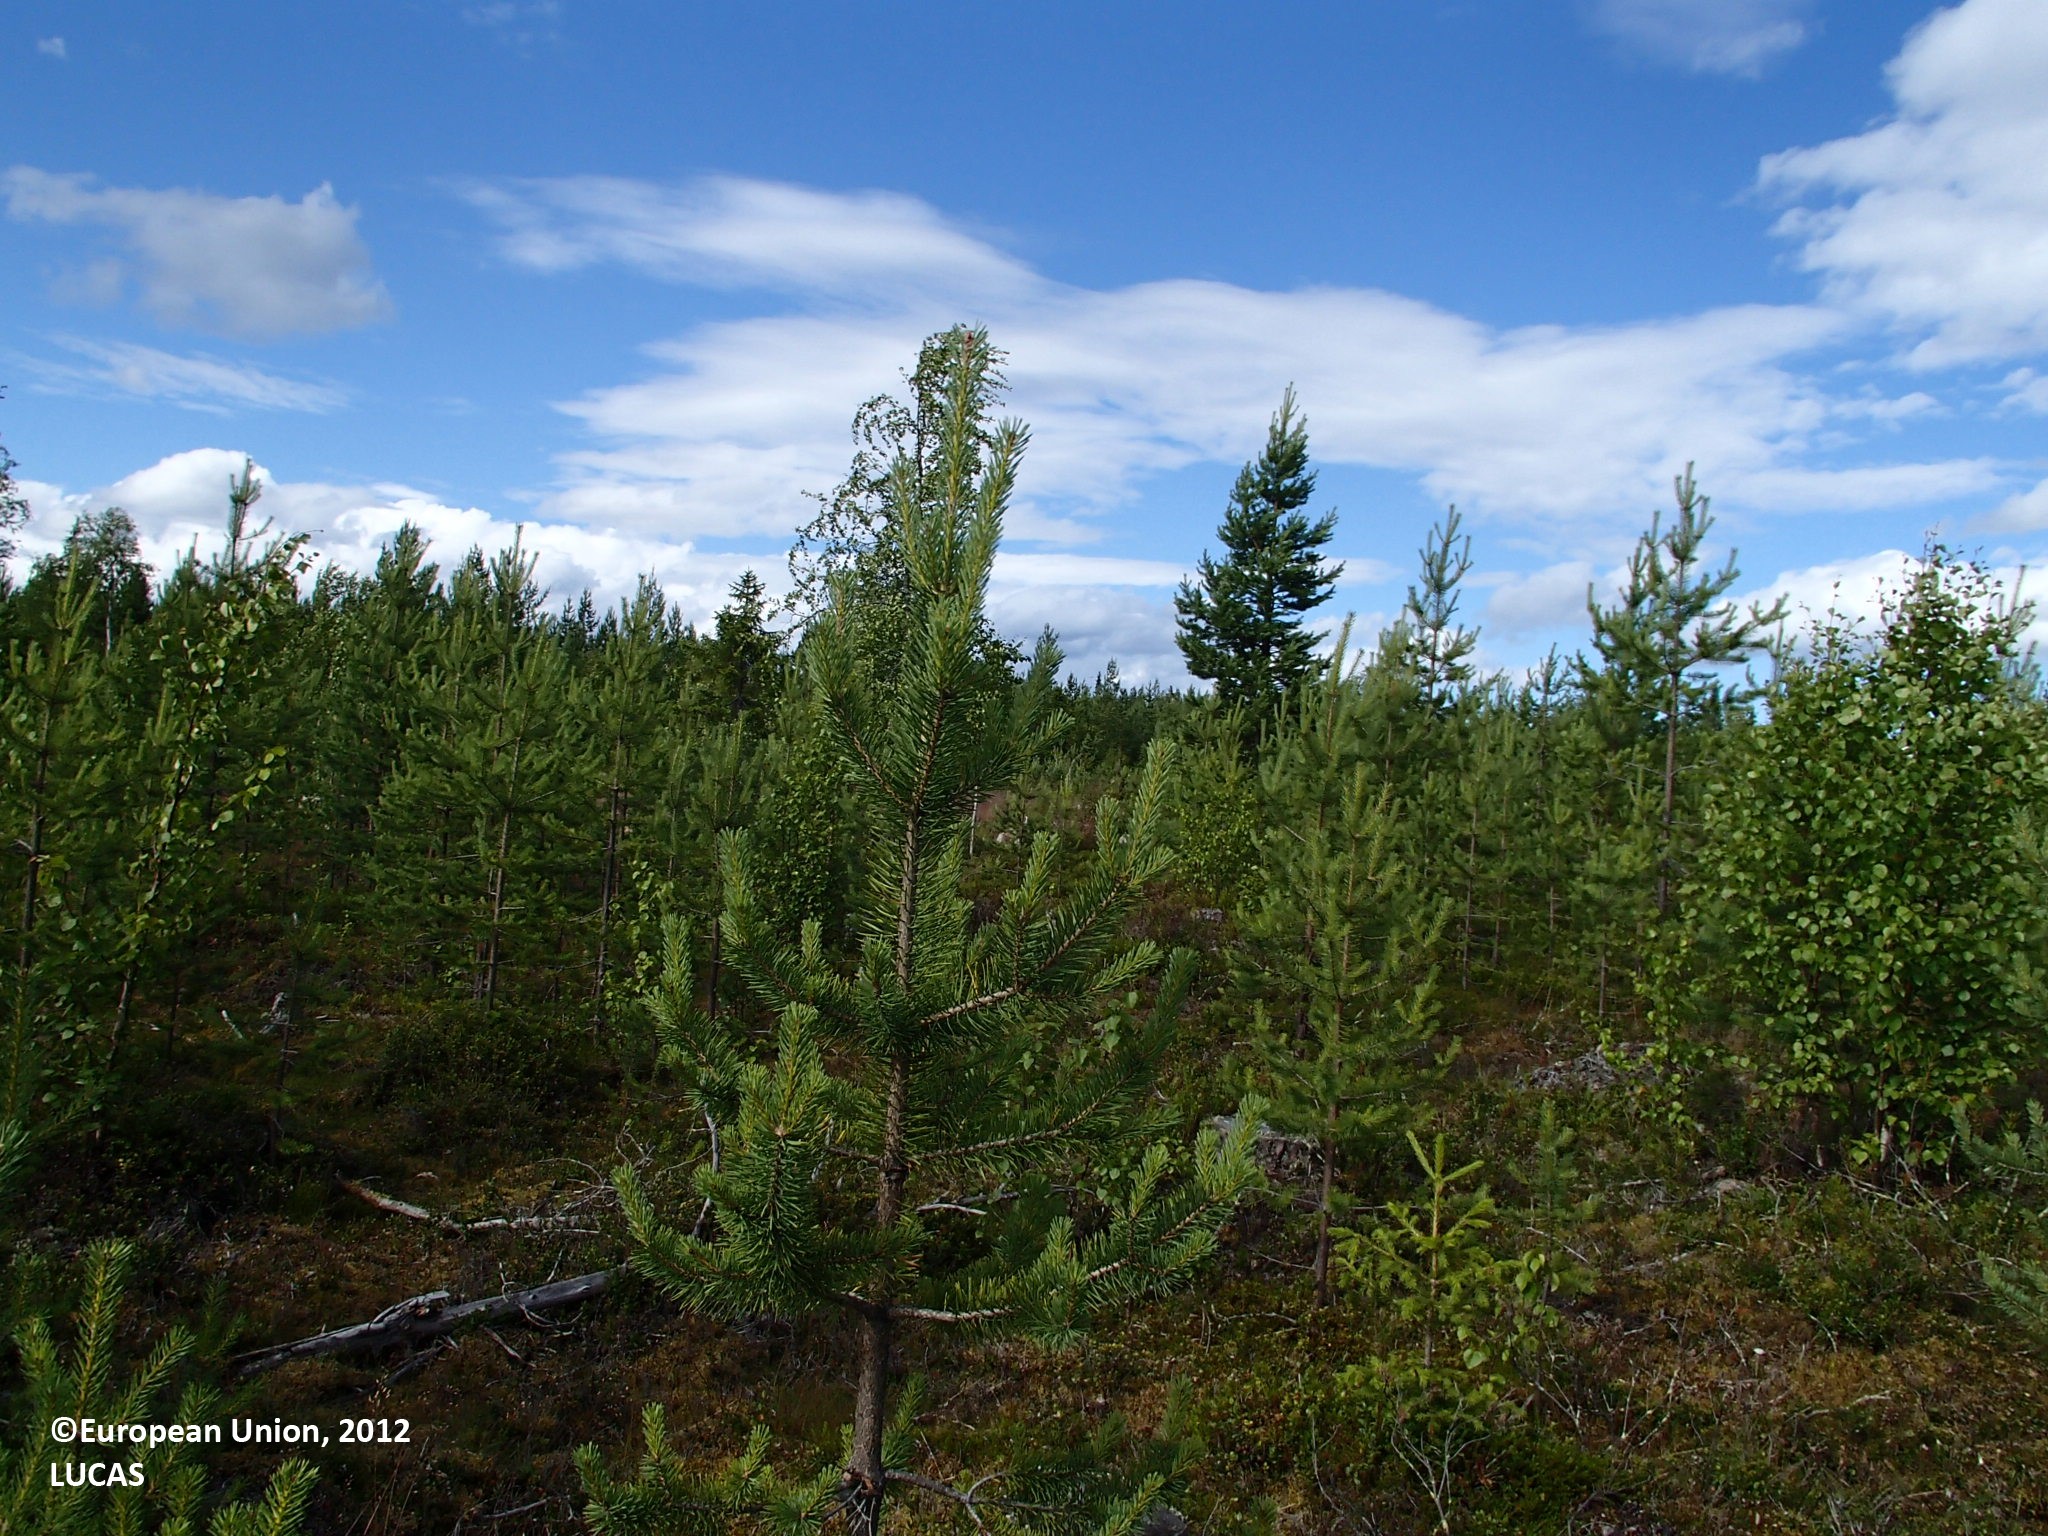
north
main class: Woodland
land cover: Other mixed woodland
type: boreal forest
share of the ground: 25 - 50 %
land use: Forestry
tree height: < 5 m
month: July
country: FI
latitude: 66.6417
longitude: 25.3608
